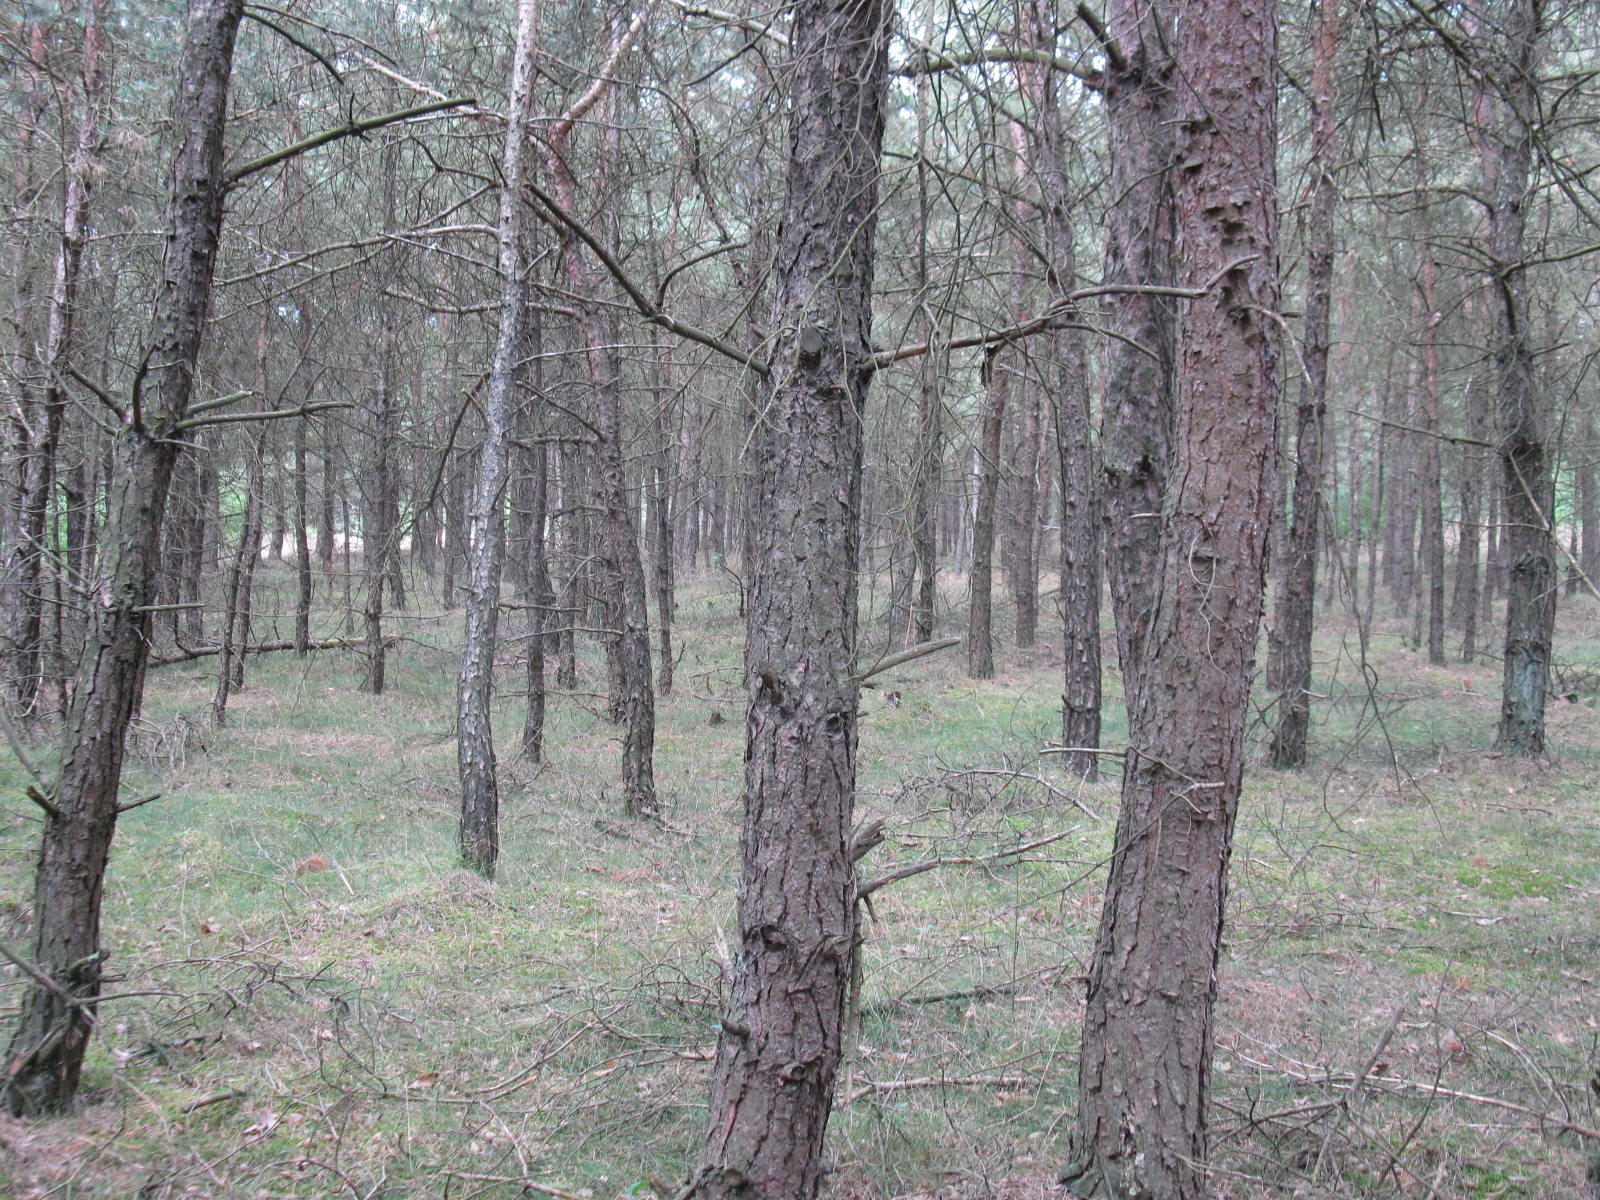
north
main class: Woodland
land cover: Pine dominated coniferous woodland
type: hemiboreal forest and nemoral coniferous forest and mixed broadleaved-coniferous forest
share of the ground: > 75 %
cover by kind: coniferous forest trees 100 %
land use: Forestry
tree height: > 5 m
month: July
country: DE
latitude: 52.9053
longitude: 8.3502
